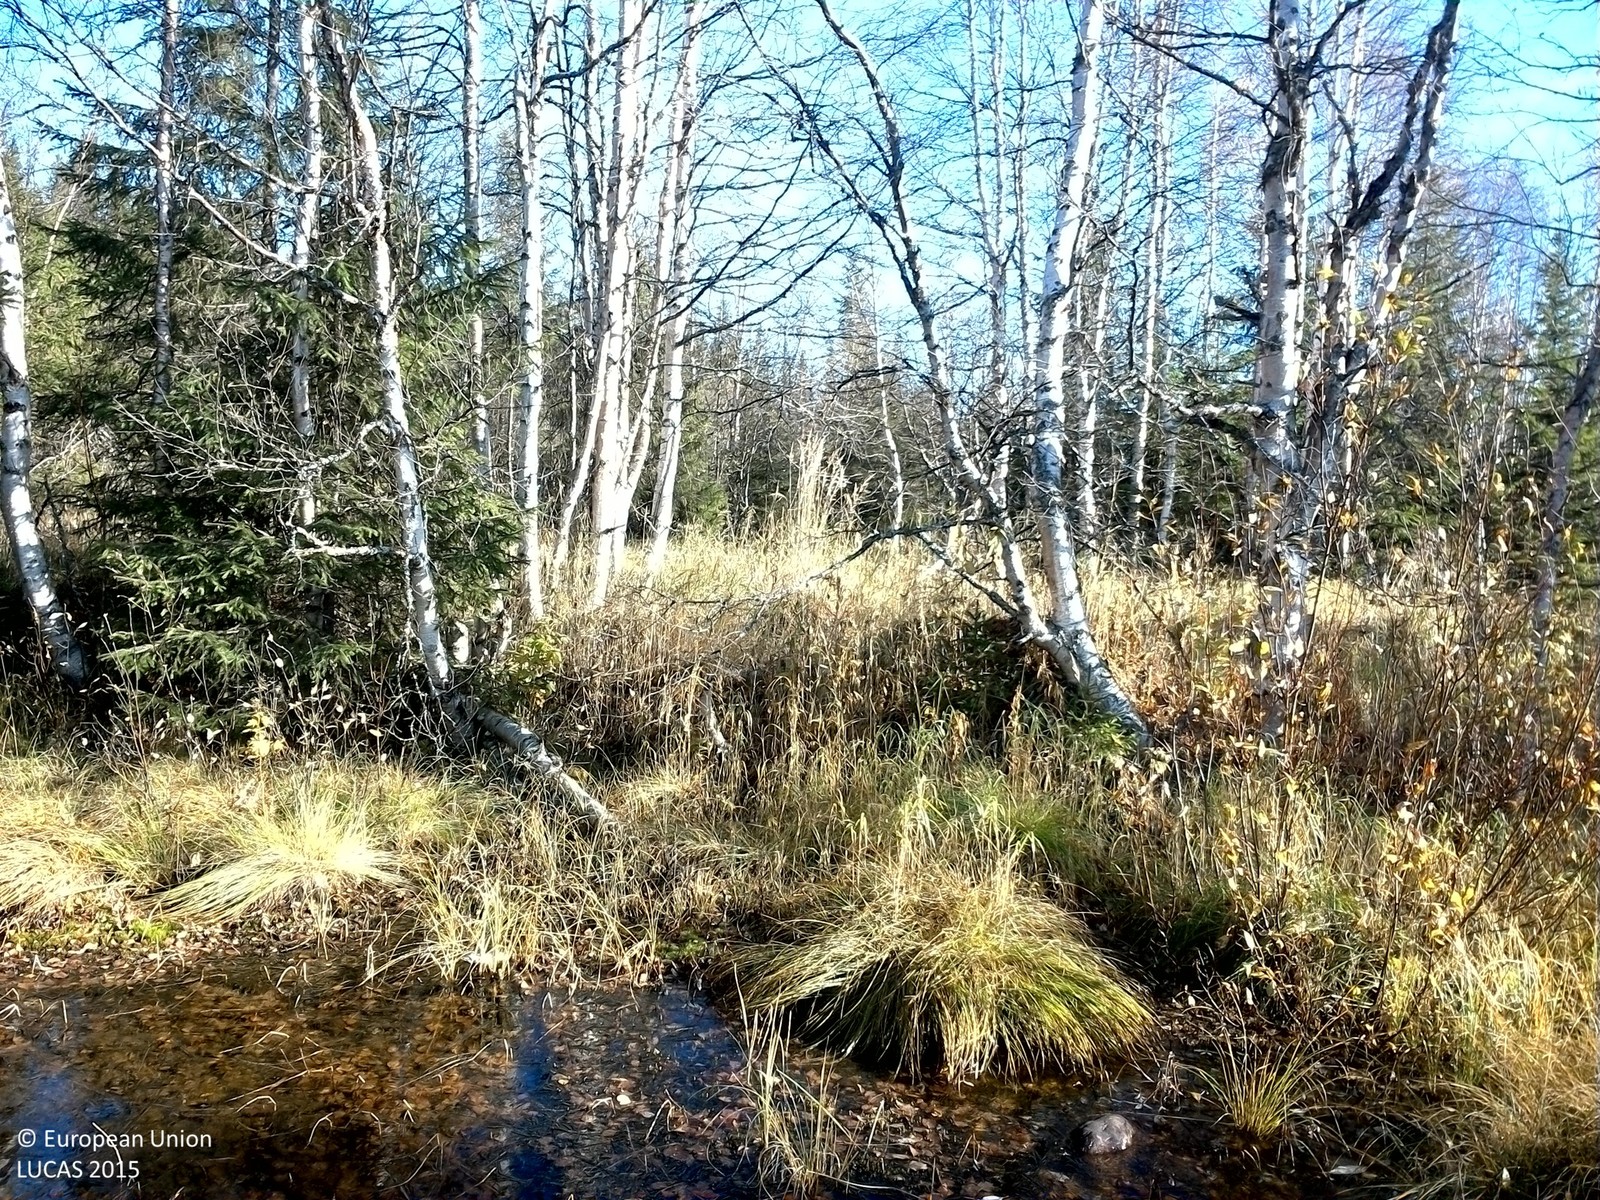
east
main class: Woodland
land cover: Spruce dominated mixed woodland
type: floodplain forest
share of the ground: 25 - 50 %
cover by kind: herbaceous plants 45 %, lichens and mosses 20 %, coniferous forest trees 15 %, broadleaved forest trees 15 %
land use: Semi-natural and natural areas not in use
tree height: < 5 m
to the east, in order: Spruce dominated mixed woodland; Grass margins; Paved roads, cycling and walking lanes; Grass margins; Groves; Inland fresh running water; Spruce dominated mixed woodland
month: October
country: SE
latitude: 64.5383
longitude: 15.4946
